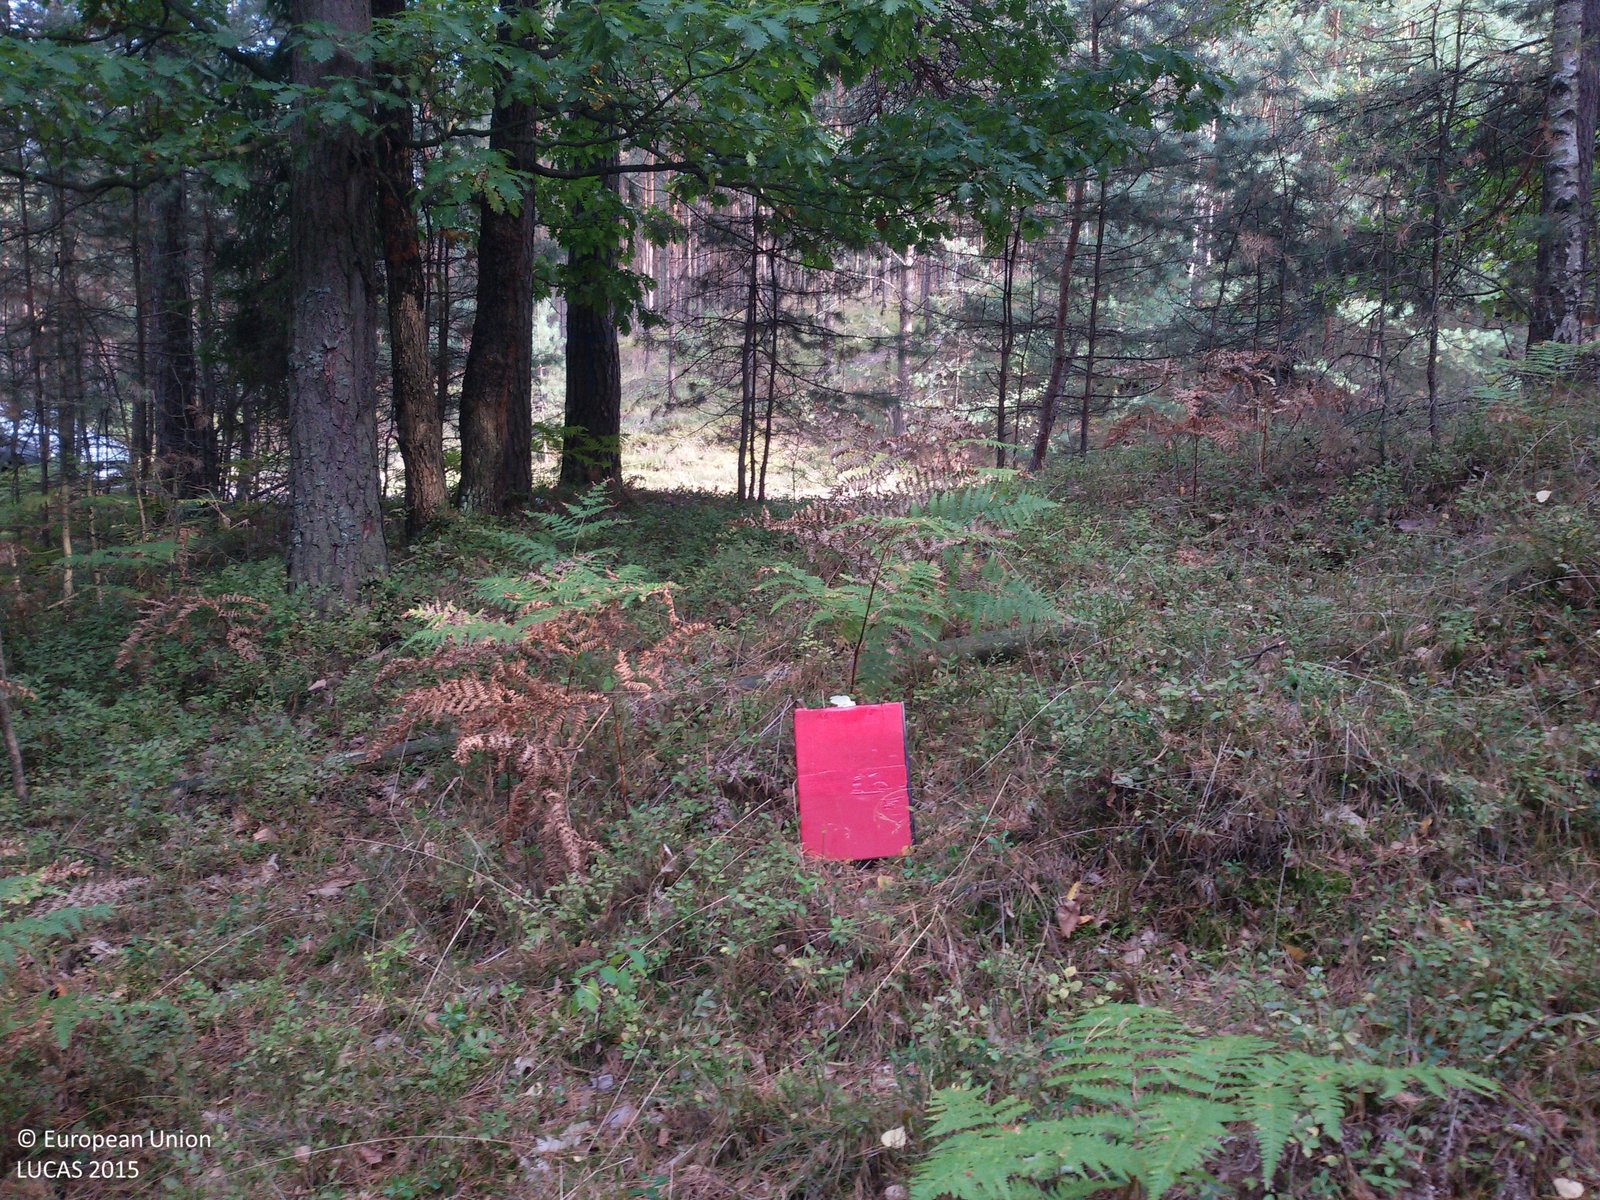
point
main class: Woodland
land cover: Pine dominated coniferous woodland
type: hemiboreal forest and nemoral coniferous forest and mixed broadleaved-coniferous forest
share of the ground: > 75 %
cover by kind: coniferous forest trees 75 %, herbaceous plants 15 %, lichens and mosses 10 %
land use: Forestry
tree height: > 5 m
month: September
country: PL
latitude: 50.7705
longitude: 18.7417
